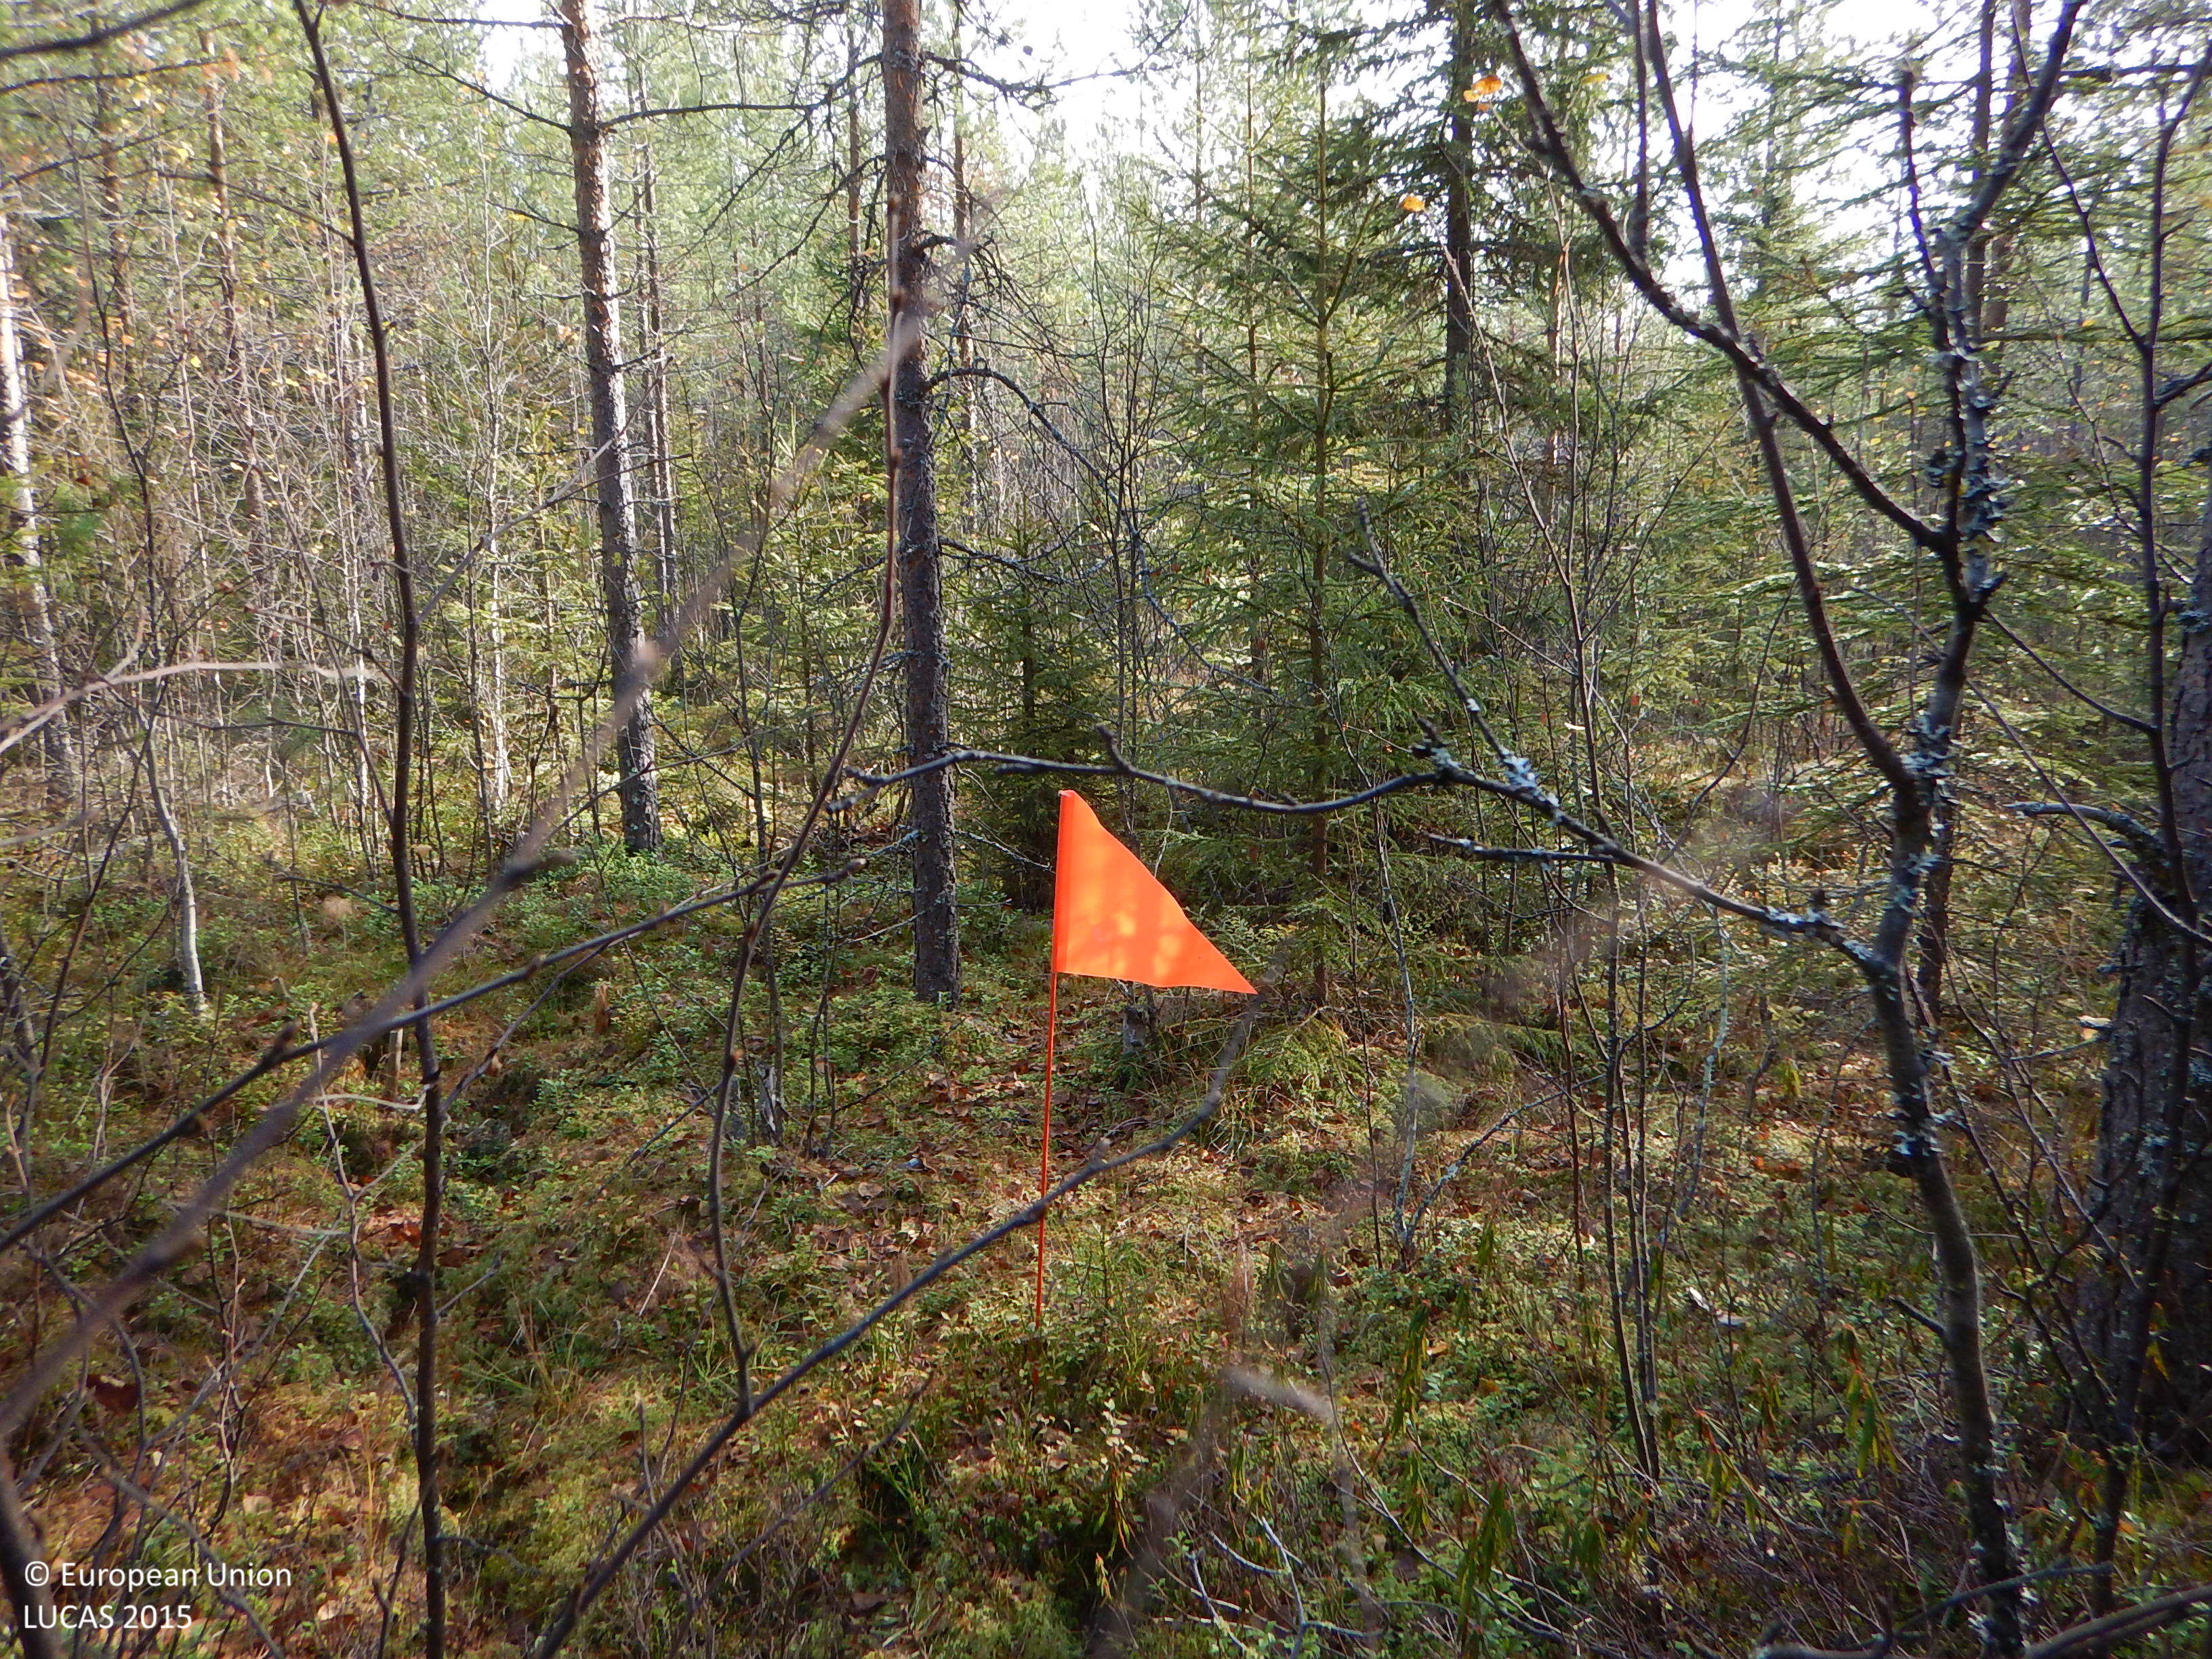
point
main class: Woodland
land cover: Pine dominated coniferous woodland
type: boreal forest
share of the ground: > 75 %
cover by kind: coniferous forest trees 65 %, broadleaved forest trees 10 %, shrubs 10 %, lichens and mosses 10 %, herbaceous plants 5 %
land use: Forestry
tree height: < 5 m
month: October
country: SE
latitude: 64.9203
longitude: 21.1202
